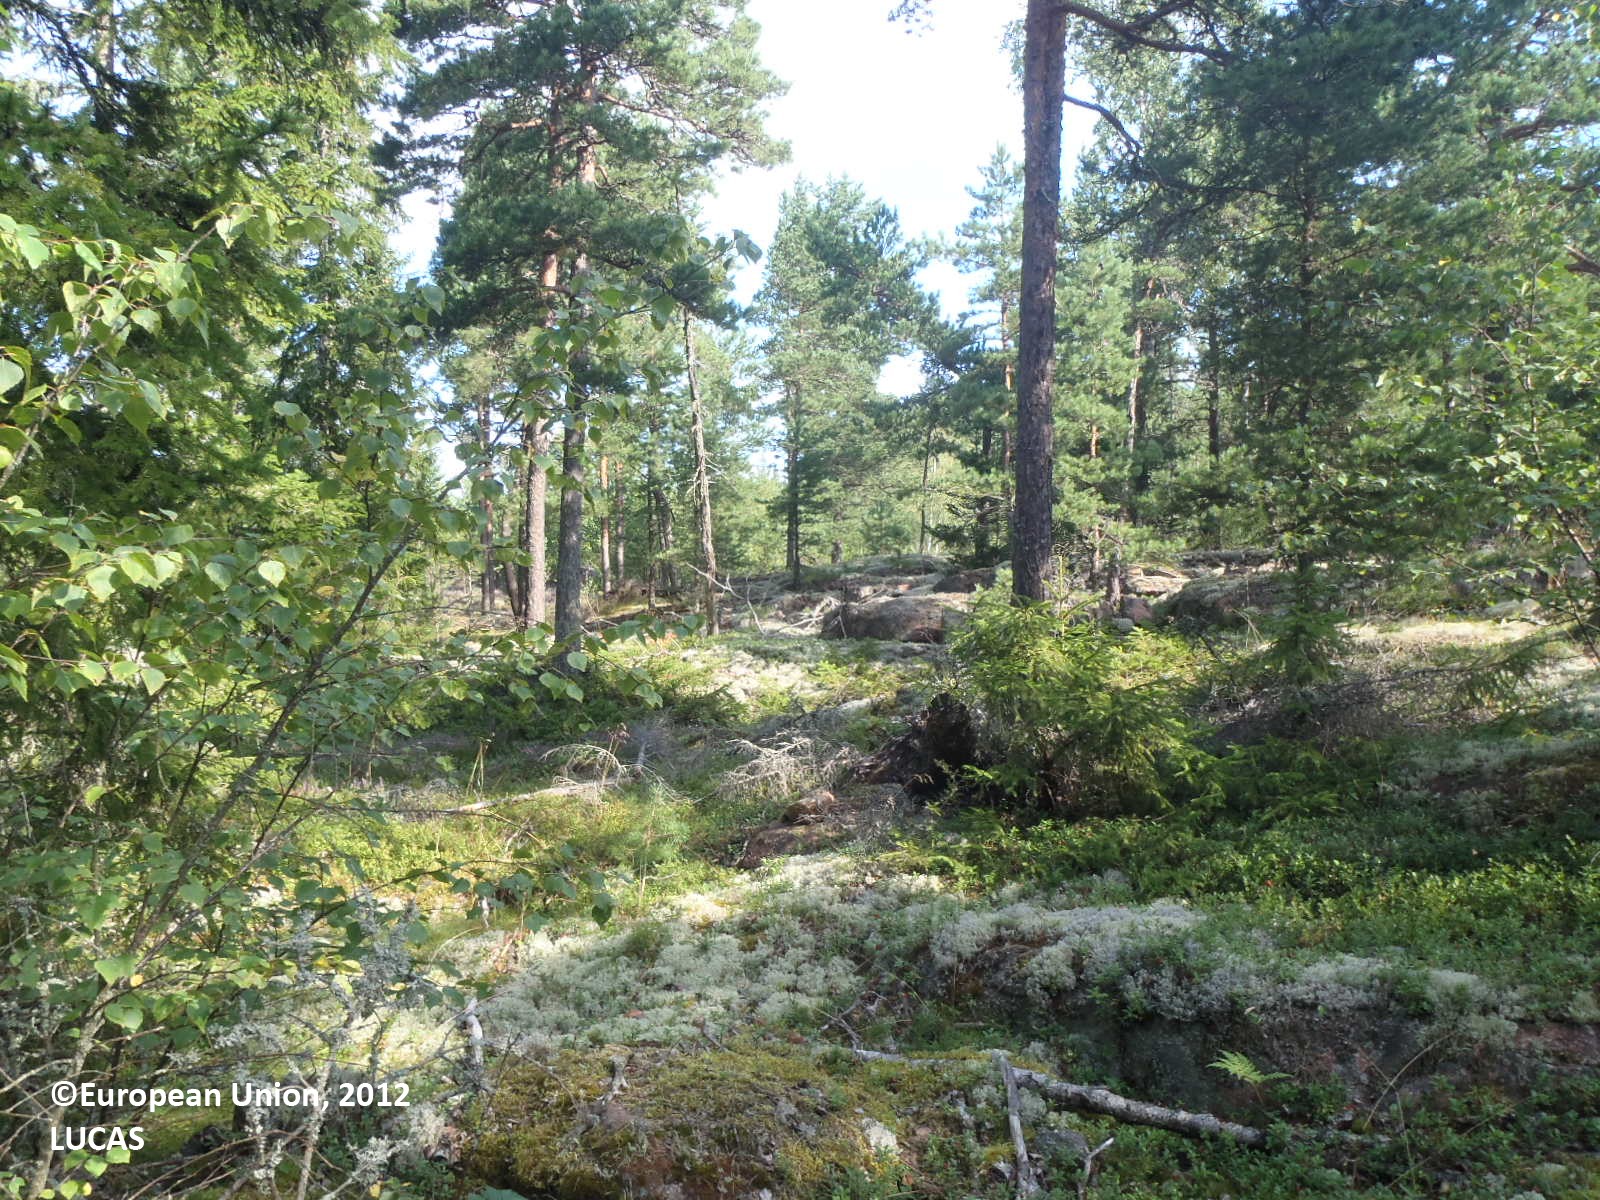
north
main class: Woodland
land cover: Pine dominated mixed woodland
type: hemiboreal forest and nemoral coniferous forest and mixed broadleaved-coniferous forest
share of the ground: 50 - 75 %
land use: Forestry
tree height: > 5 m
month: August
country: FI
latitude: 60.1867
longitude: 20.2694
